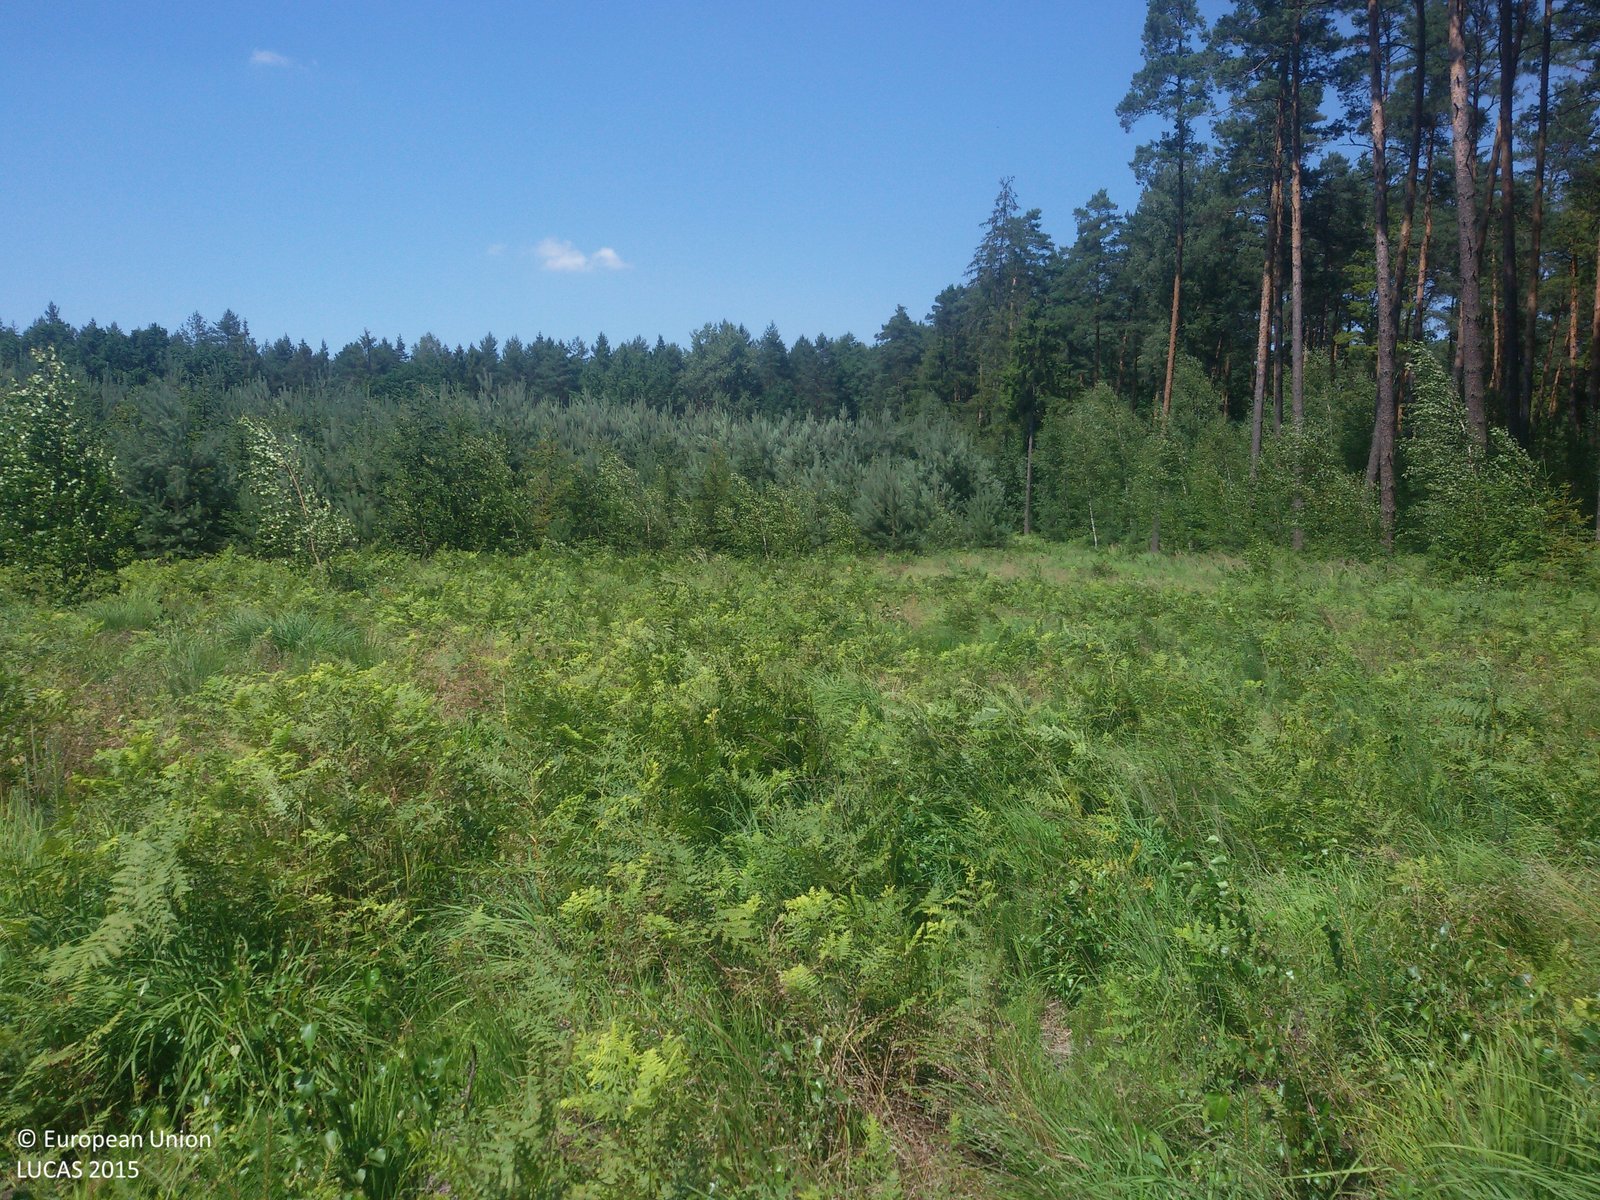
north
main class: Grassland
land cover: Spontaneously vegetated surfaces
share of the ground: > 75 %
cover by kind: herbaceous plants 100 %
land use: Forestry
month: July
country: PL
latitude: 50.5592
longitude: 17.6503
